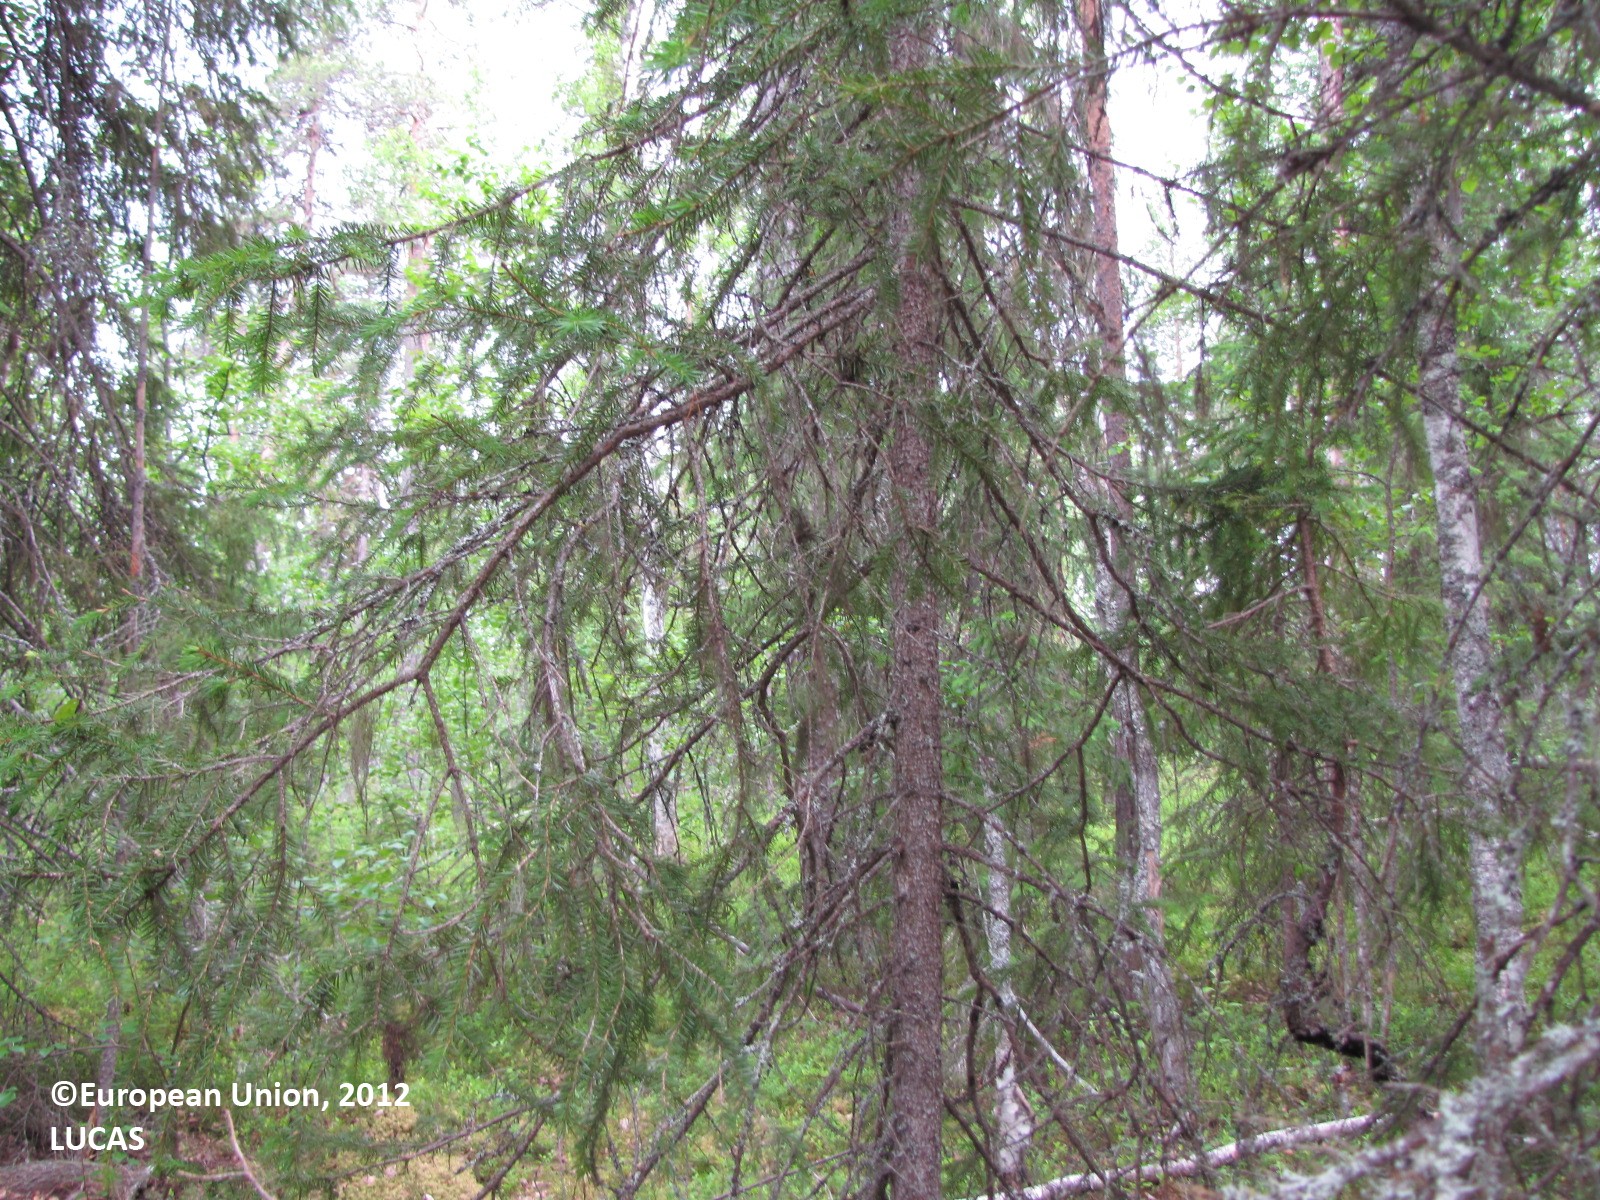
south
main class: Woodland
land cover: Spruce dominated mixed woodland
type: boreal forest
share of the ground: 50 - 75 %
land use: Forestry
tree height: > 5 m
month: July
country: FI
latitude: 66.6380
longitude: 24.9897
